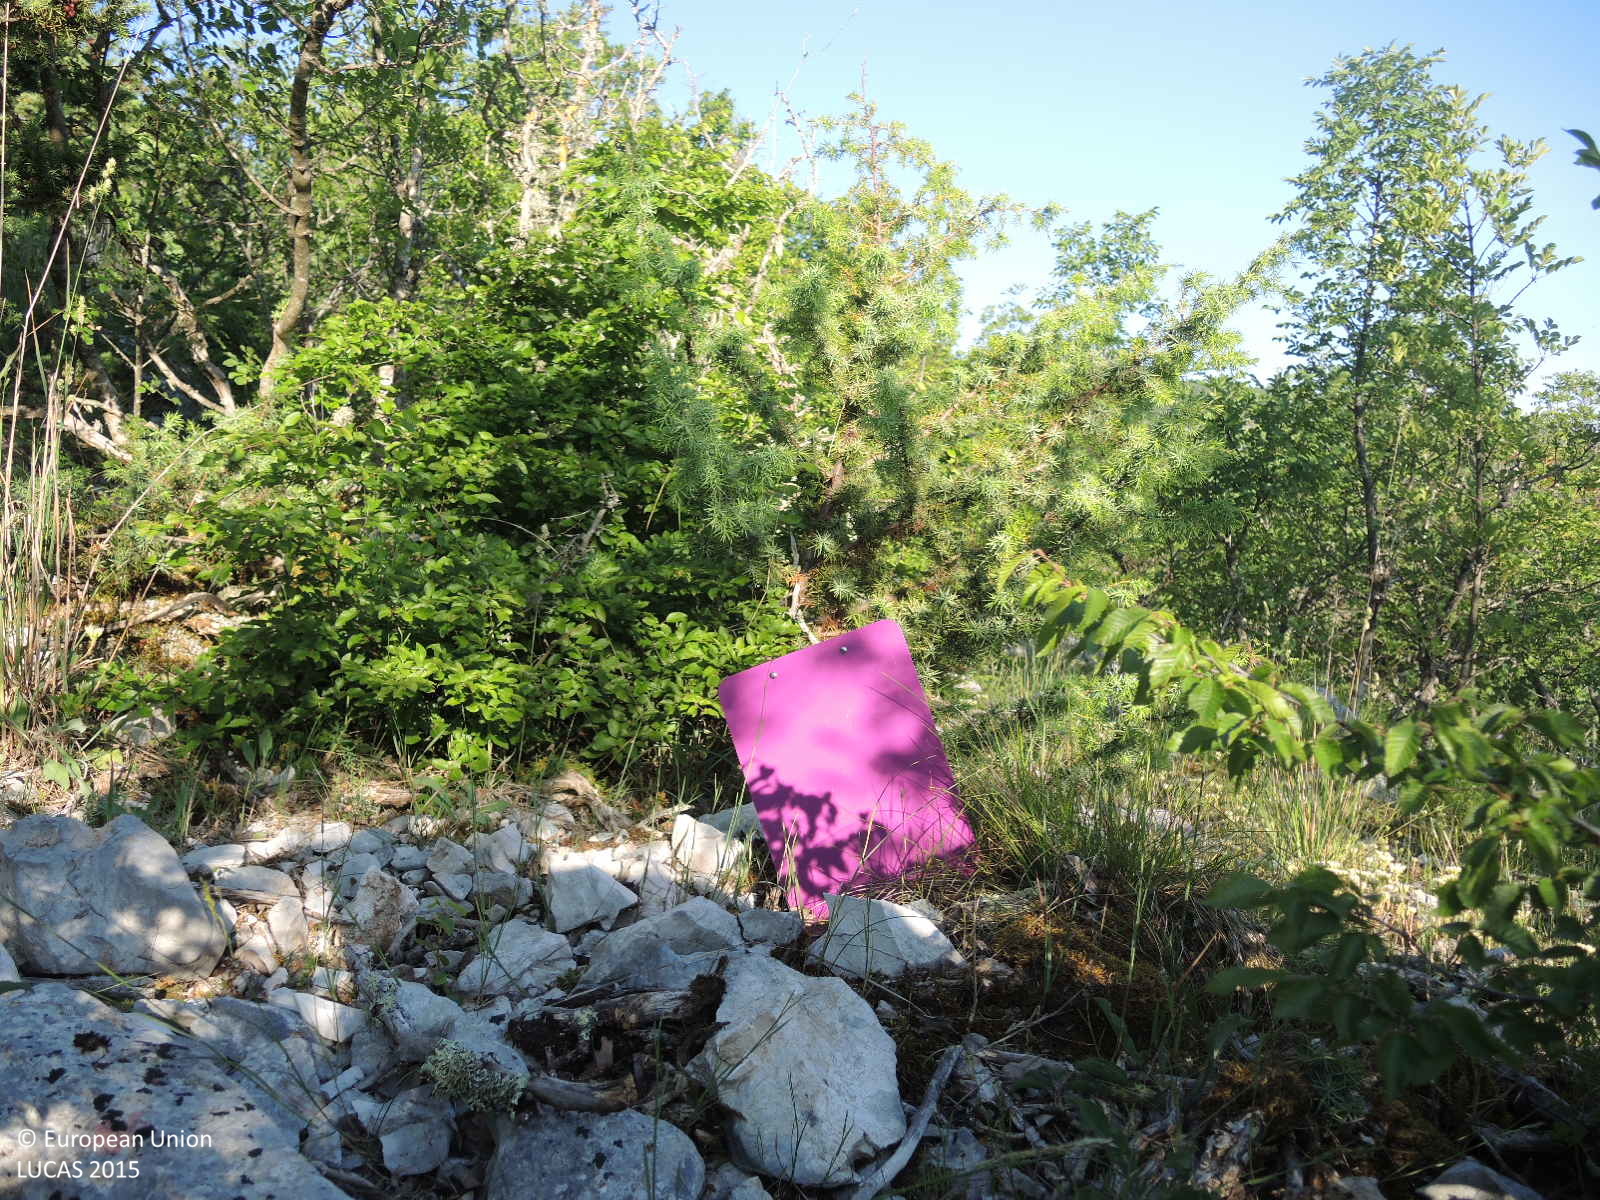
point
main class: Woodland
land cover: Broadleaved woodland
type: thermophilous deciduous forest
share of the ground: > 75 %
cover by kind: broadleaved forest trees 50 %, shrubs 30 %, consolidated bare surface 10 %, unconsolidated bare surface 10 %
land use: Semi-natural and natural areas not in use
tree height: < 5 m
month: June
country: HR
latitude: 43.6614
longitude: 16.1541
